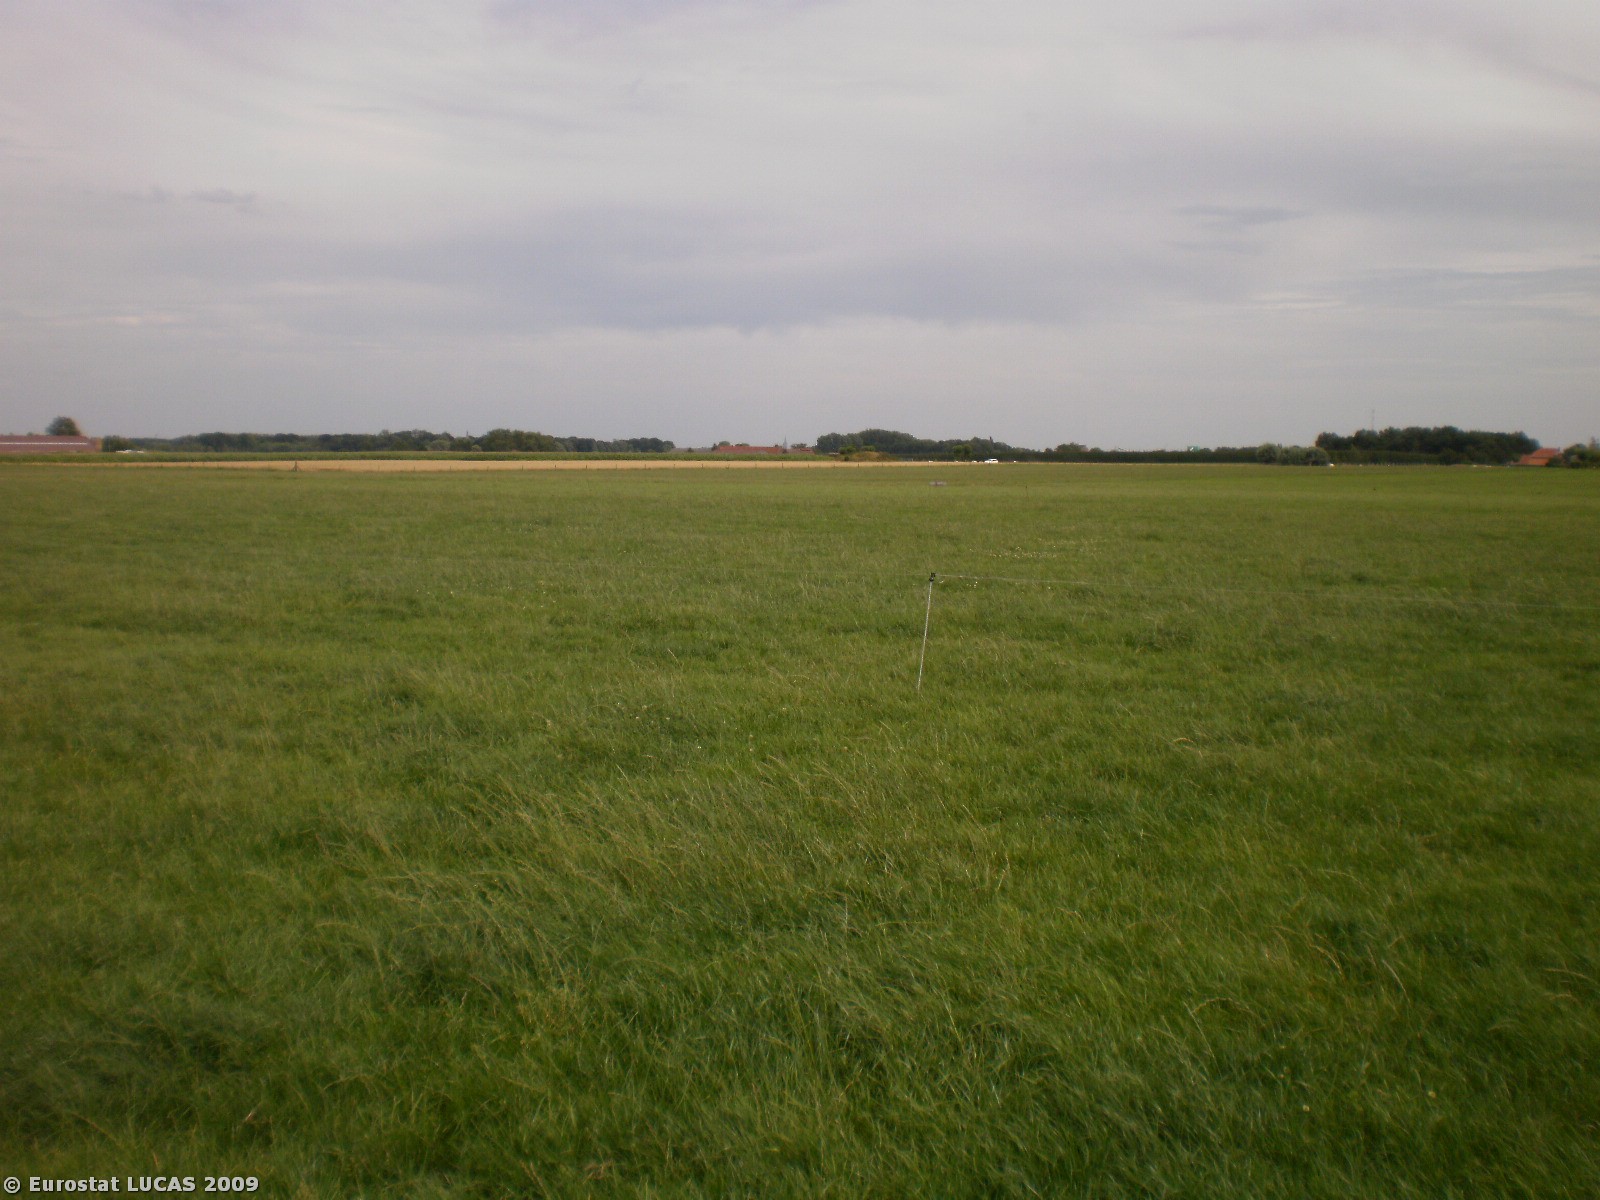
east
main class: Grassland
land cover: Grassland without tree/shrub cover
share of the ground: > 75 %
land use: Agriculture (excluding fallow land and kitchen gardens)
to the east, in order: Grassland without tree/shrub cover; Tracks; Grassland without tree/shrub cover; Fences; Common wheat
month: July
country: BE
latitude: 50.8583
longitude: 2.7862
